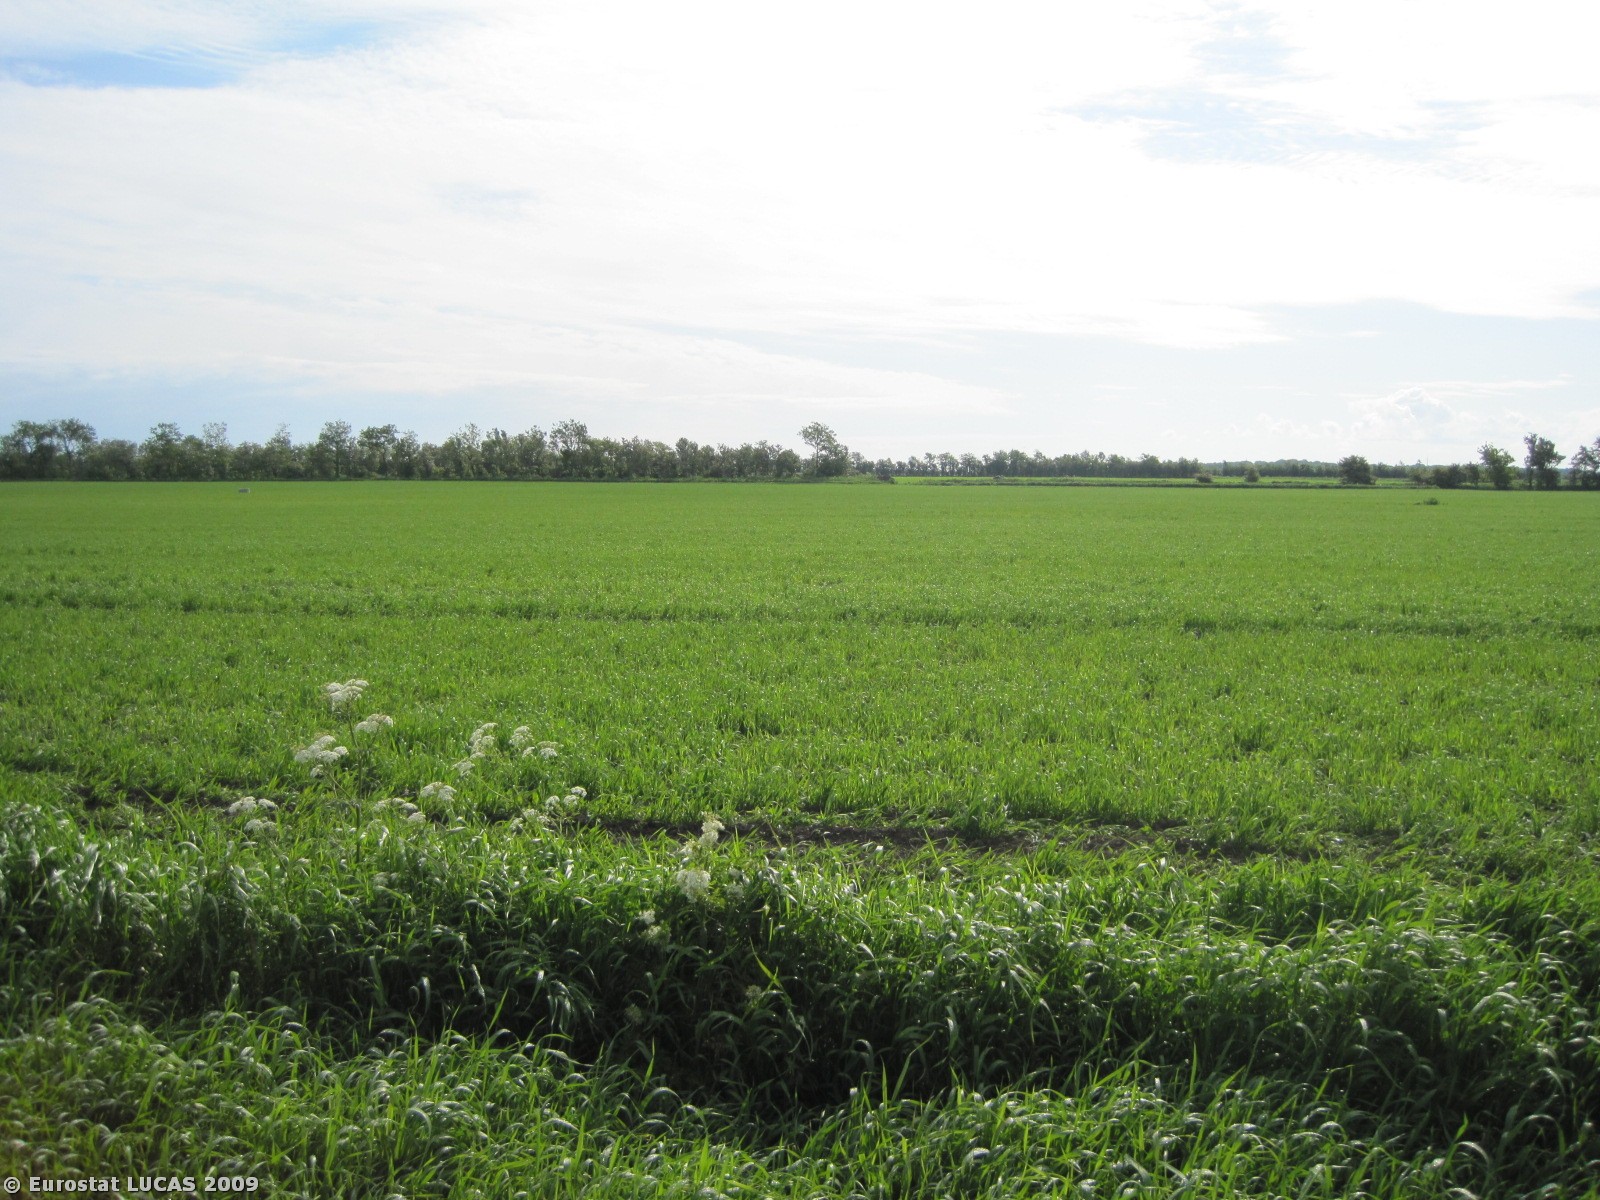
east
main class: Cropland
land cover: Barley
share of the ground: > 75 %
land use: Agriculture (excluding fallow land and kitchen gardens)
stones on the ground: < 10 %
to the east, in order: Barley; Grass margins; Rye; Grass margins; Inland water bodies; Grassland without tree/shrub cover; Tracks; Grass margins; Barley
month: June
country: DK
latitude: 57.1044
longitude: 10.2143
